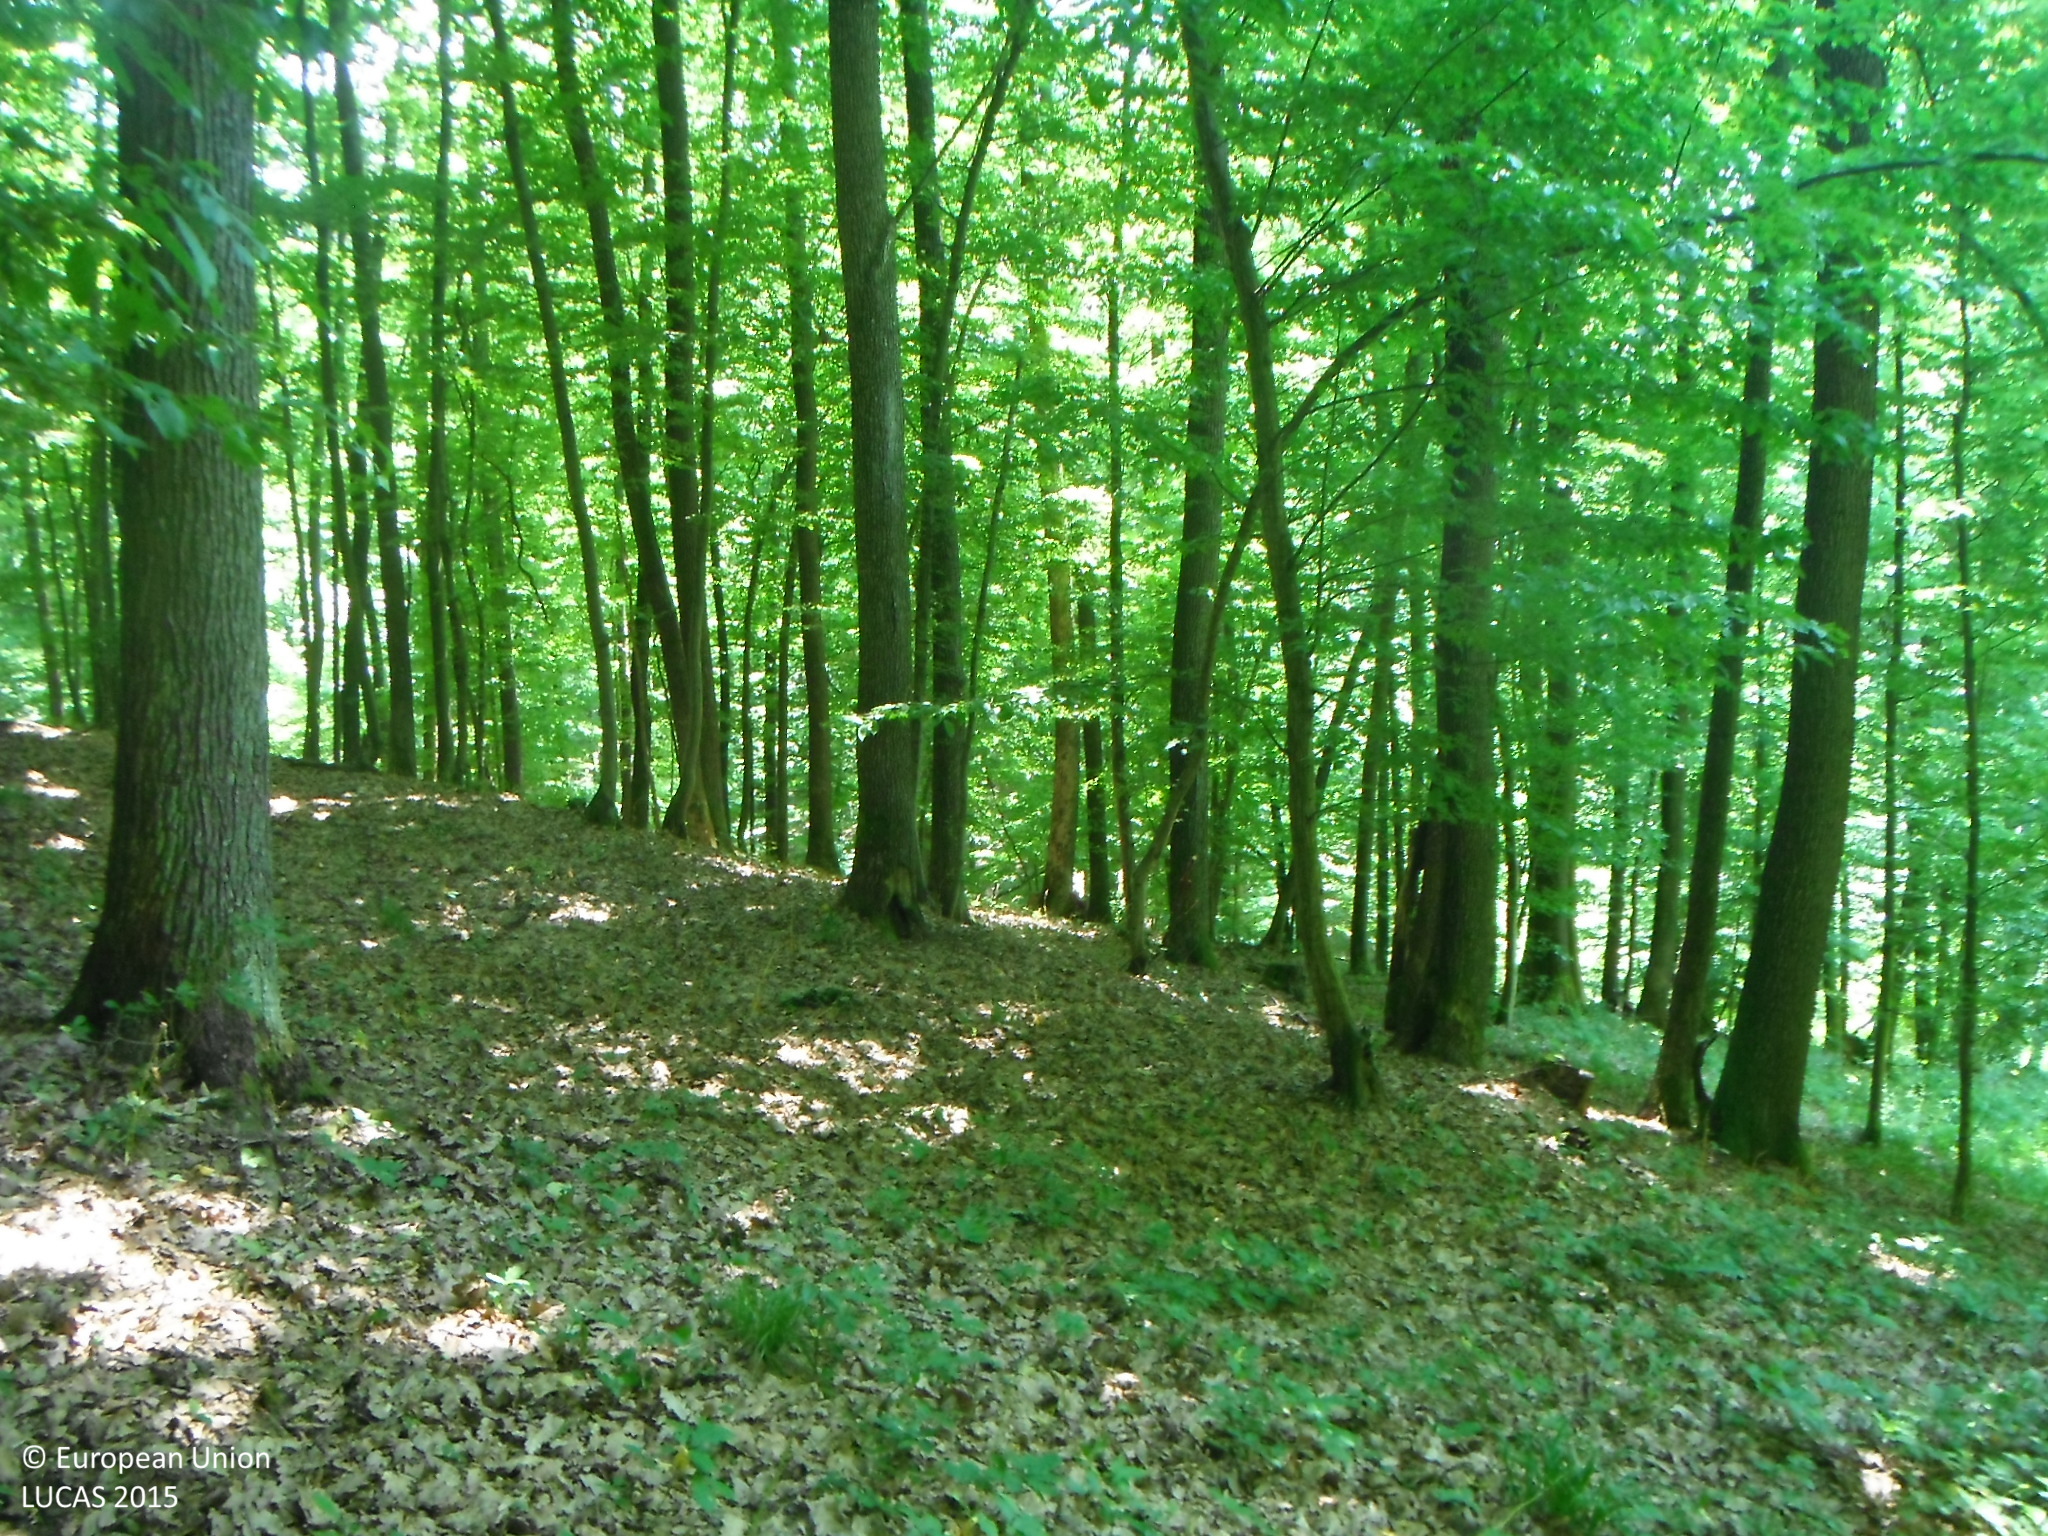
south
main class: Woodland
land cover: Broadleaved woodland
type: mesophytic deciduous forest
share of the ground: > 75 %
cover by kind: broadleaved forest trees 100 %
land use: Forestry
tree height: > 5 m
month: June
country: SK
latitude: 48.6720
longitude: 19.1889
